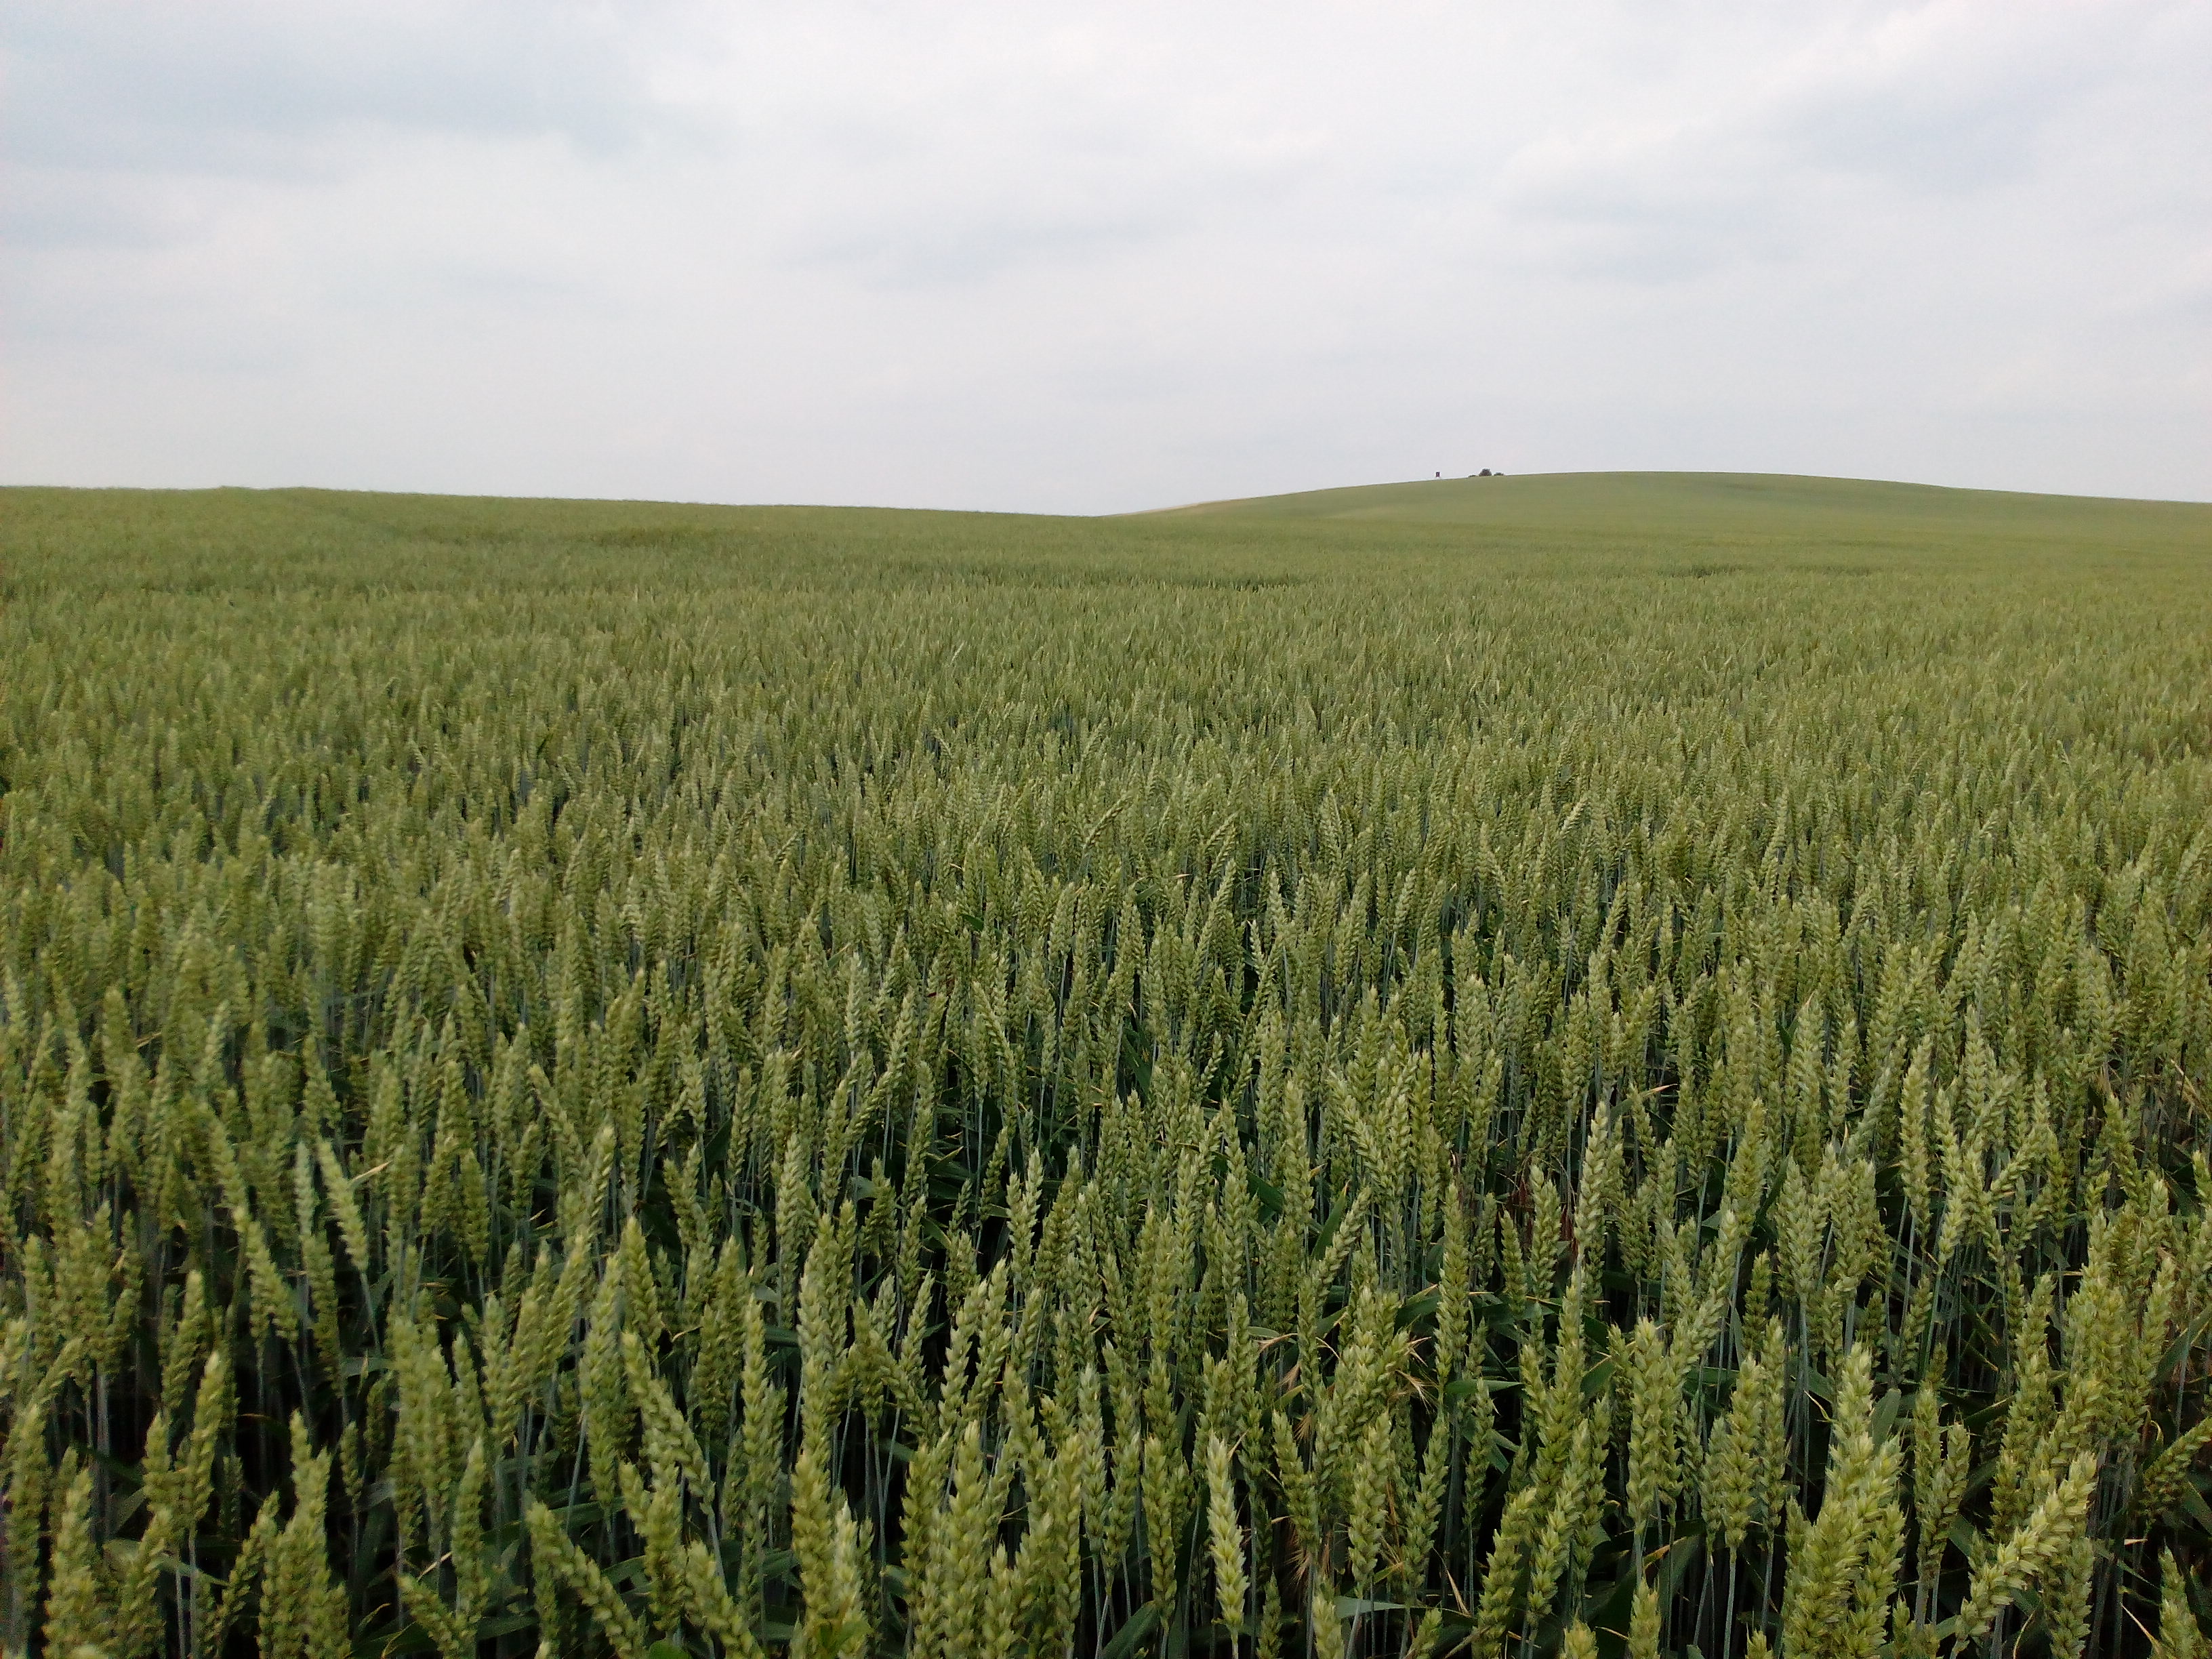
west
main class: Cropland
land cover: Common wheat
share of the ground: > 75 %
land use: Agriculture (excluding fallow land and kitchen gardens)
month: June
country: DE
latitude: 51.2757
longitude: 11.1035
